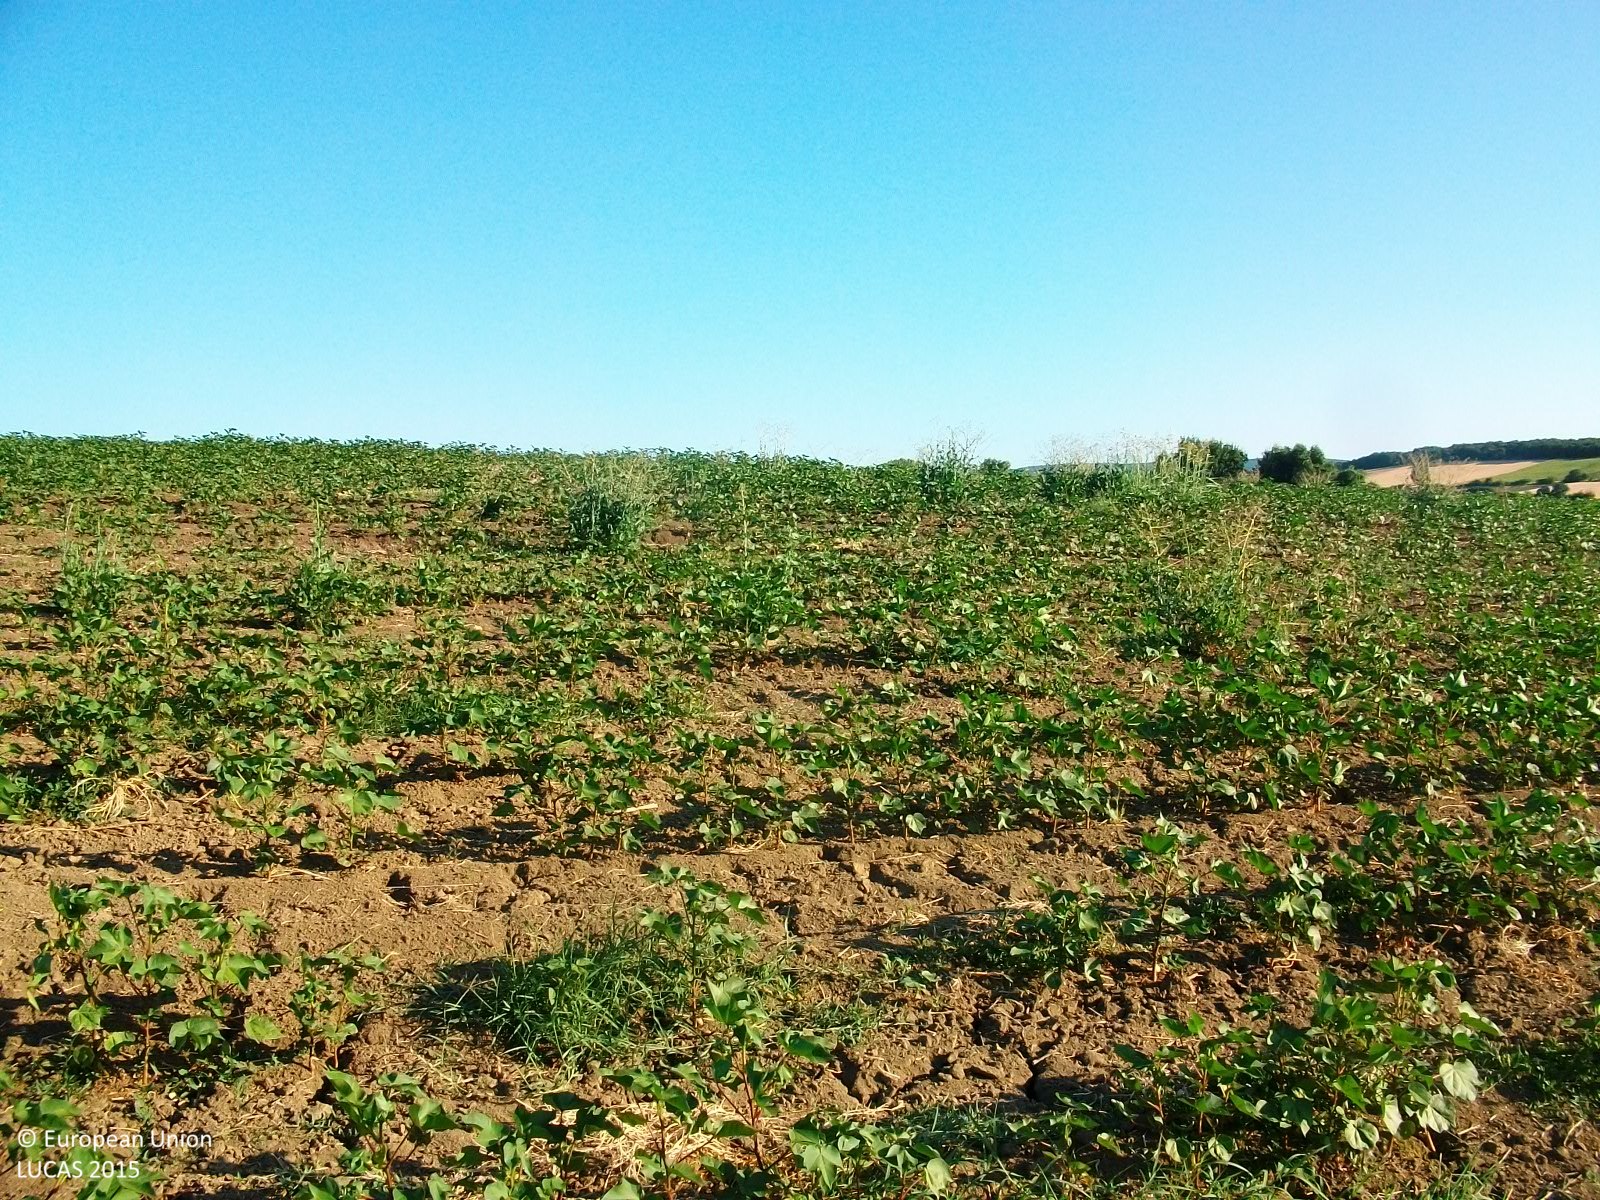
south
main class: Cropland
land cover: Cotton
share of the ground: 25 - 50 %
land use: Agriculture (excluding fallow land and kitchen gardens)
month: July
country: GR
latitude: 41.4607
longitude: 26.2470
